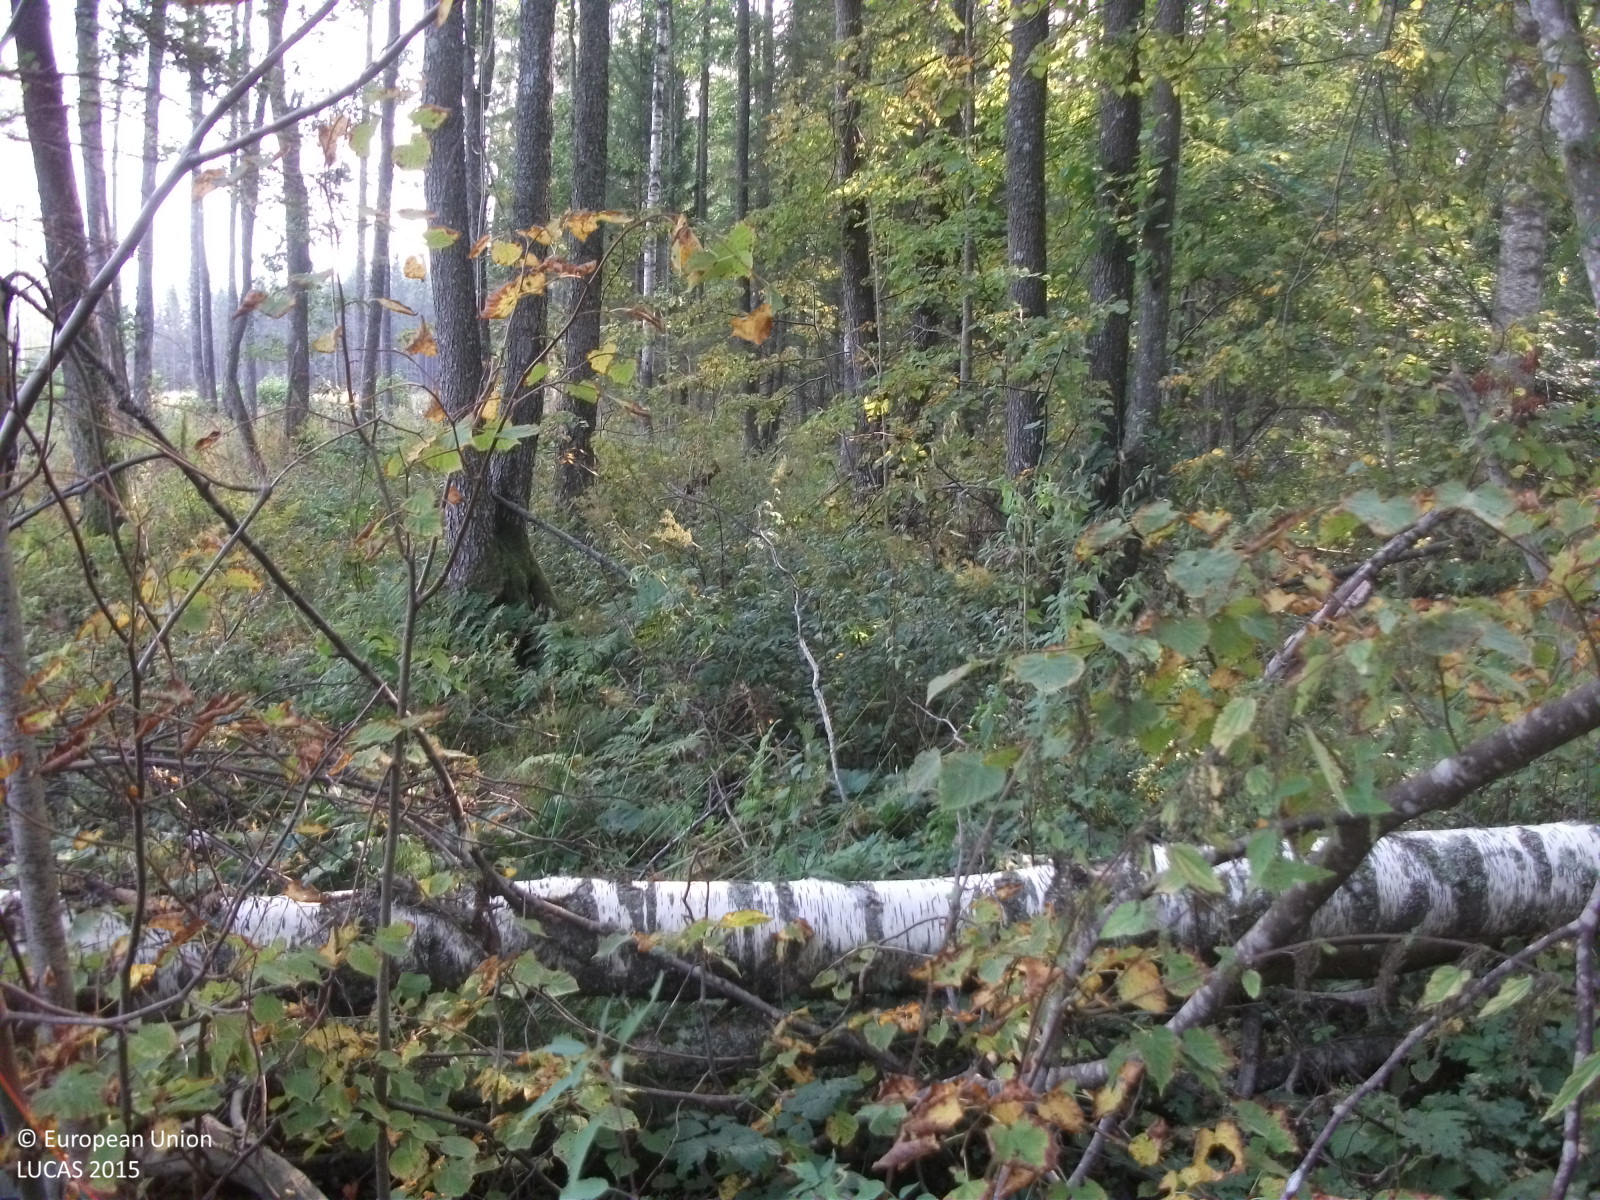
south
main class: Woodland
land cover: Broadleaved woodland
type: non-riverine alder, birch or aspen forest
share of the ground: > 75 %
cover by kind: broadleaved forest trees 80 %, herbaceous plants 10 %, shrubs 5 %
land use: Forestry
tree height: > 5 m
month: September
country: LV
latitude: 57.8383
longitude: 24.5934
